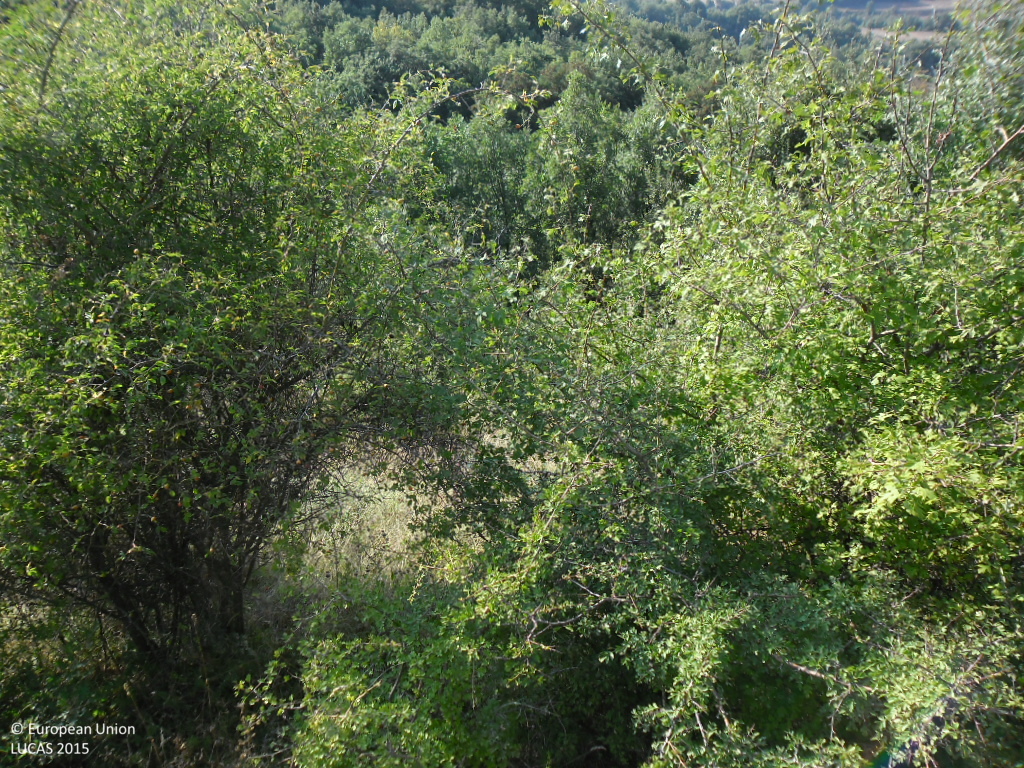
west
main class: Woodland
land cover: Broadleaved woodland
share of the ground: 50 - 75 %
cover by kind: broadleaved forest trees 70 %, herbaceous plants 20 %, shrubs 10 %
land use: Forestry
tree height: < 5 m
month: August
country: BG
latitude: 41.9626
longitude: 22.9685
